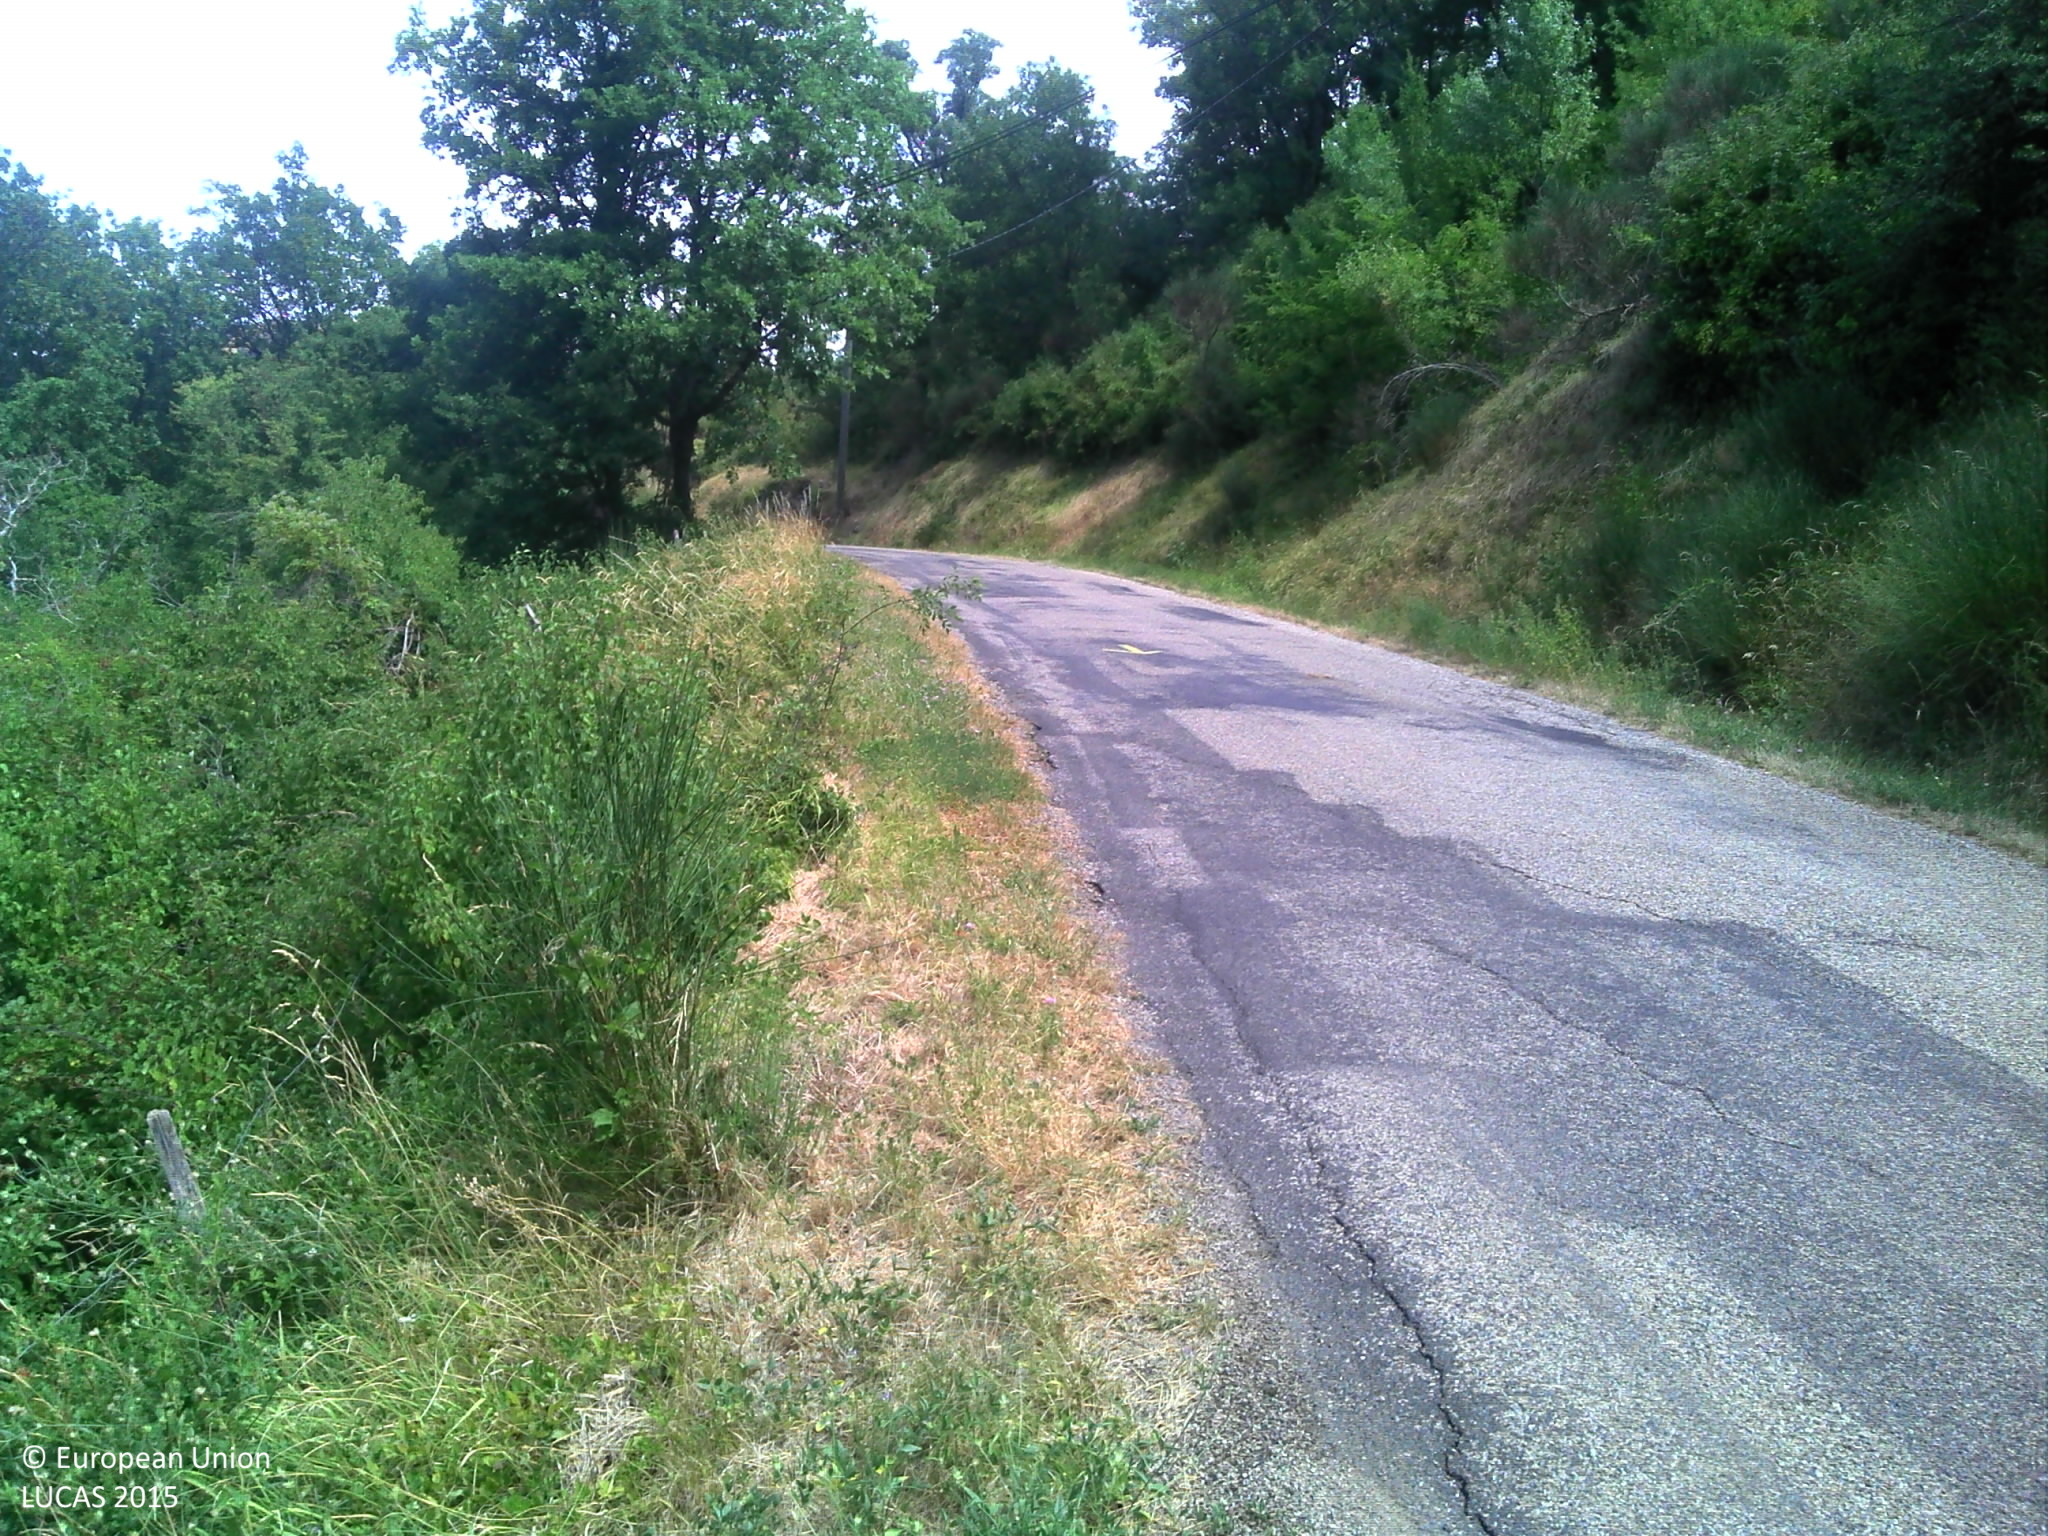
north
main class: Woodland
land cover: Broadleaved woodland
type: broadleaved evergreen forest
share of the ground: > 75 %
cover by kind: broadleaved forest trees 80 %, shrubs 10 %, herbaceous plants 10 %
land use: Semi-natural and natural areas not in use
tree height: > 5 m
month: July
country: FR
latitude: 44.6076
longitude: 4.6010
